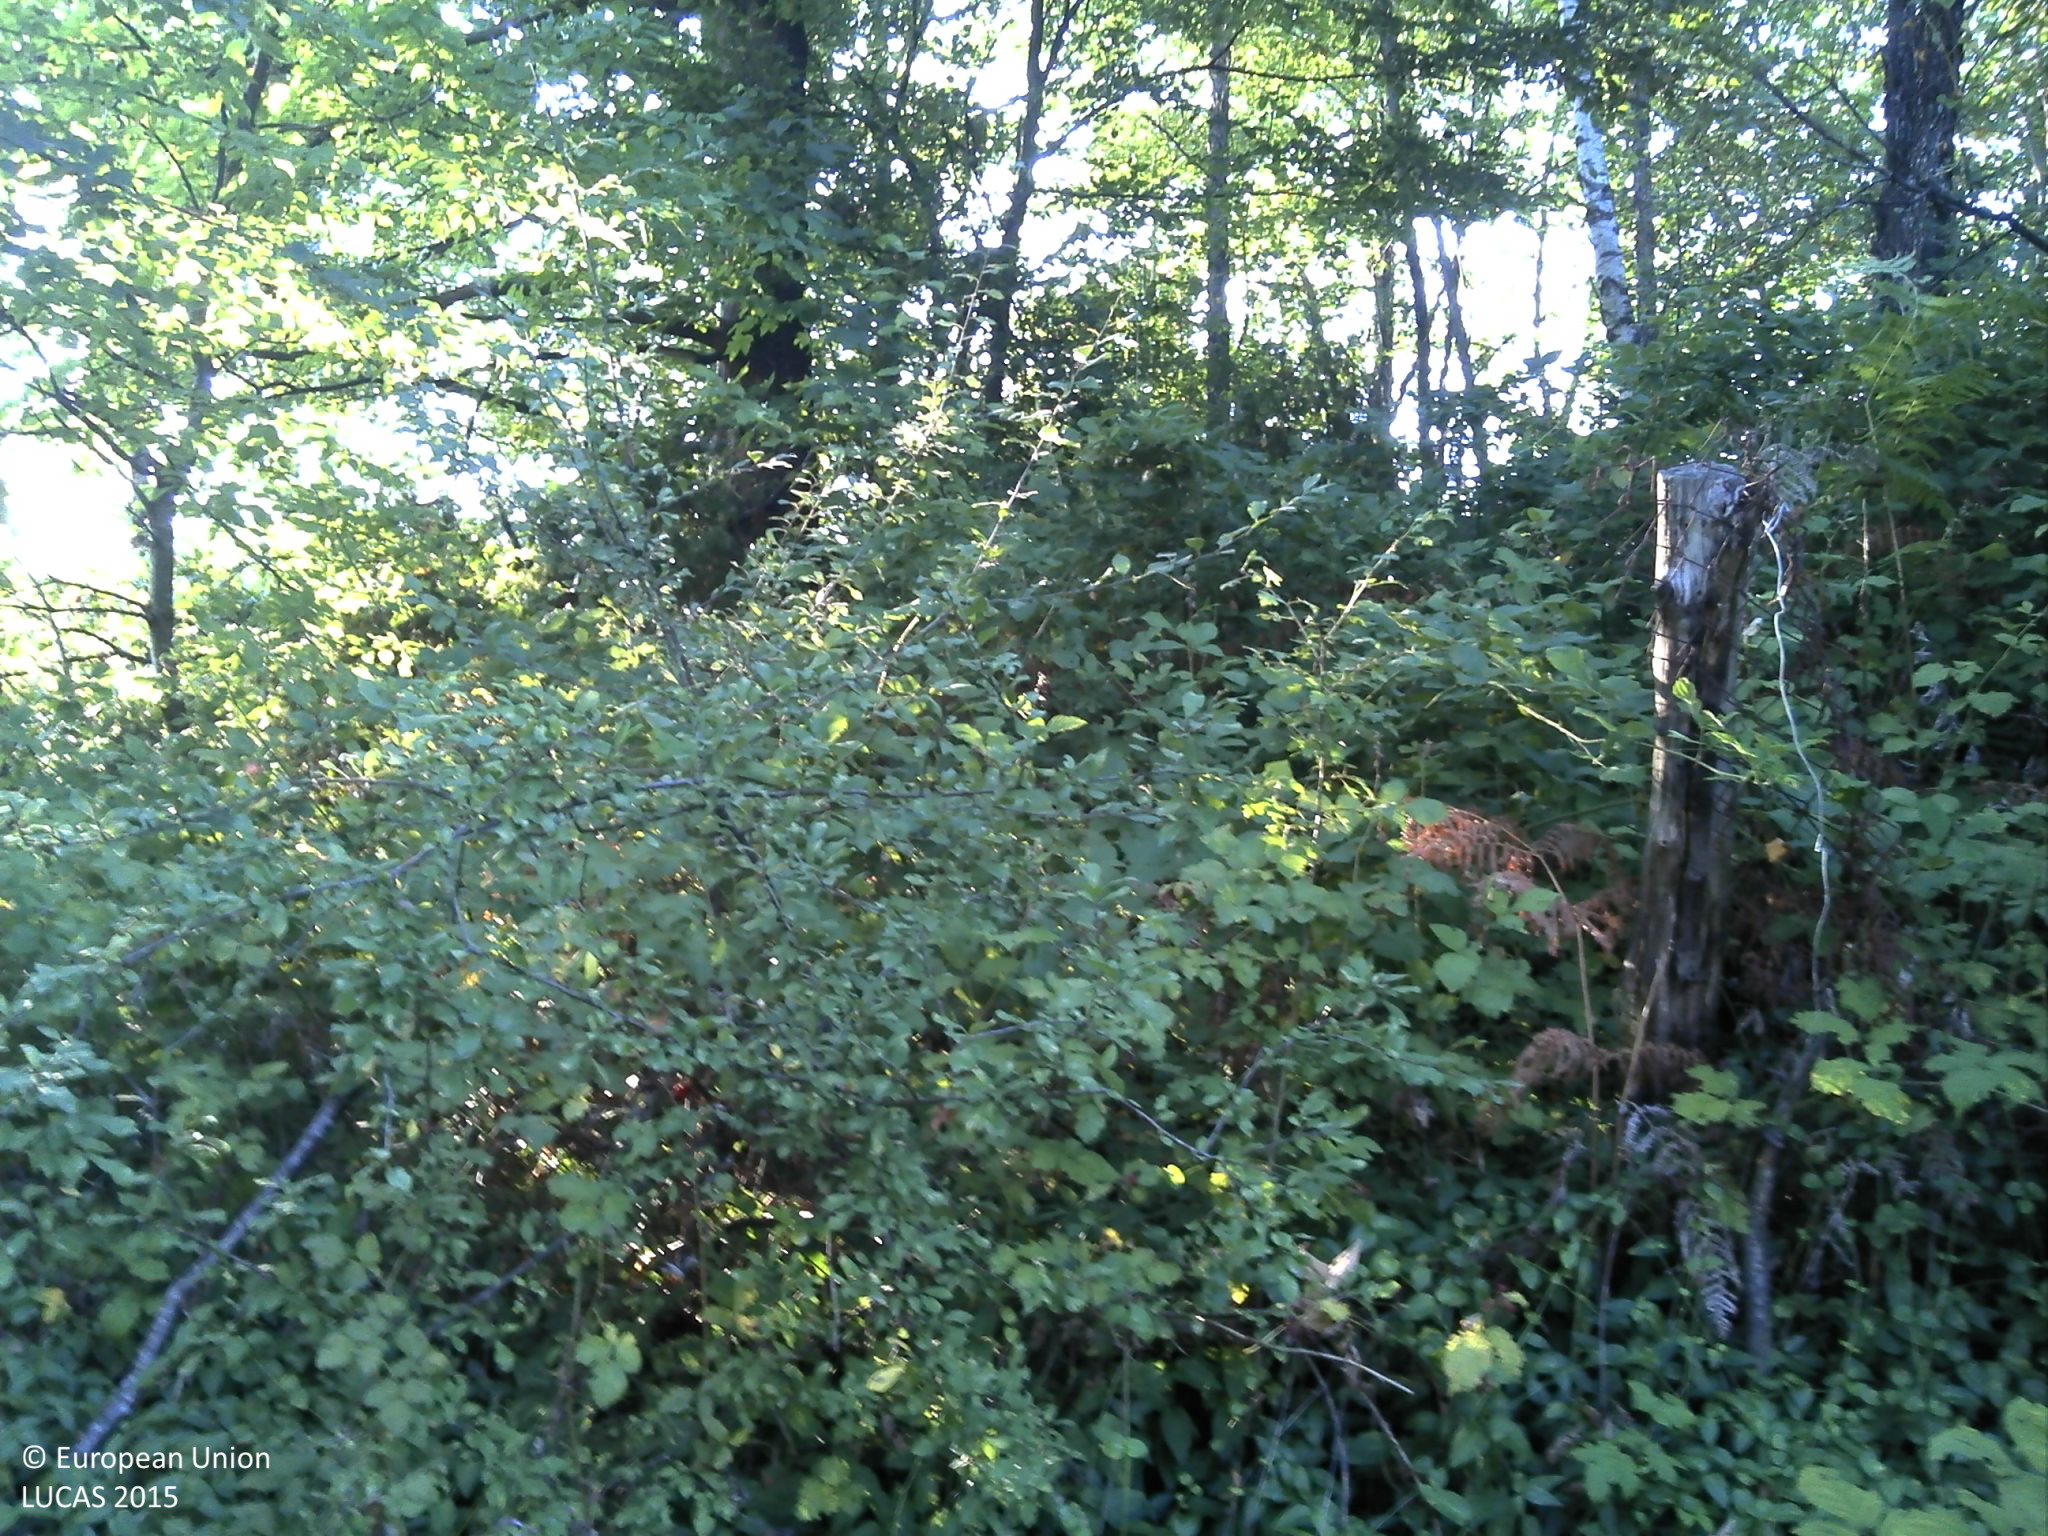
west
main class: Woodland
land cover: Broadleaved woodland
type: beech forest
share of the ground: > 75 %
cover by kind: broadleaved forest trees 100 %
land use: Forestry
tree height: > 5 m
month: August
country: HR
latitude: 45.3571
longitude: 15.9068
